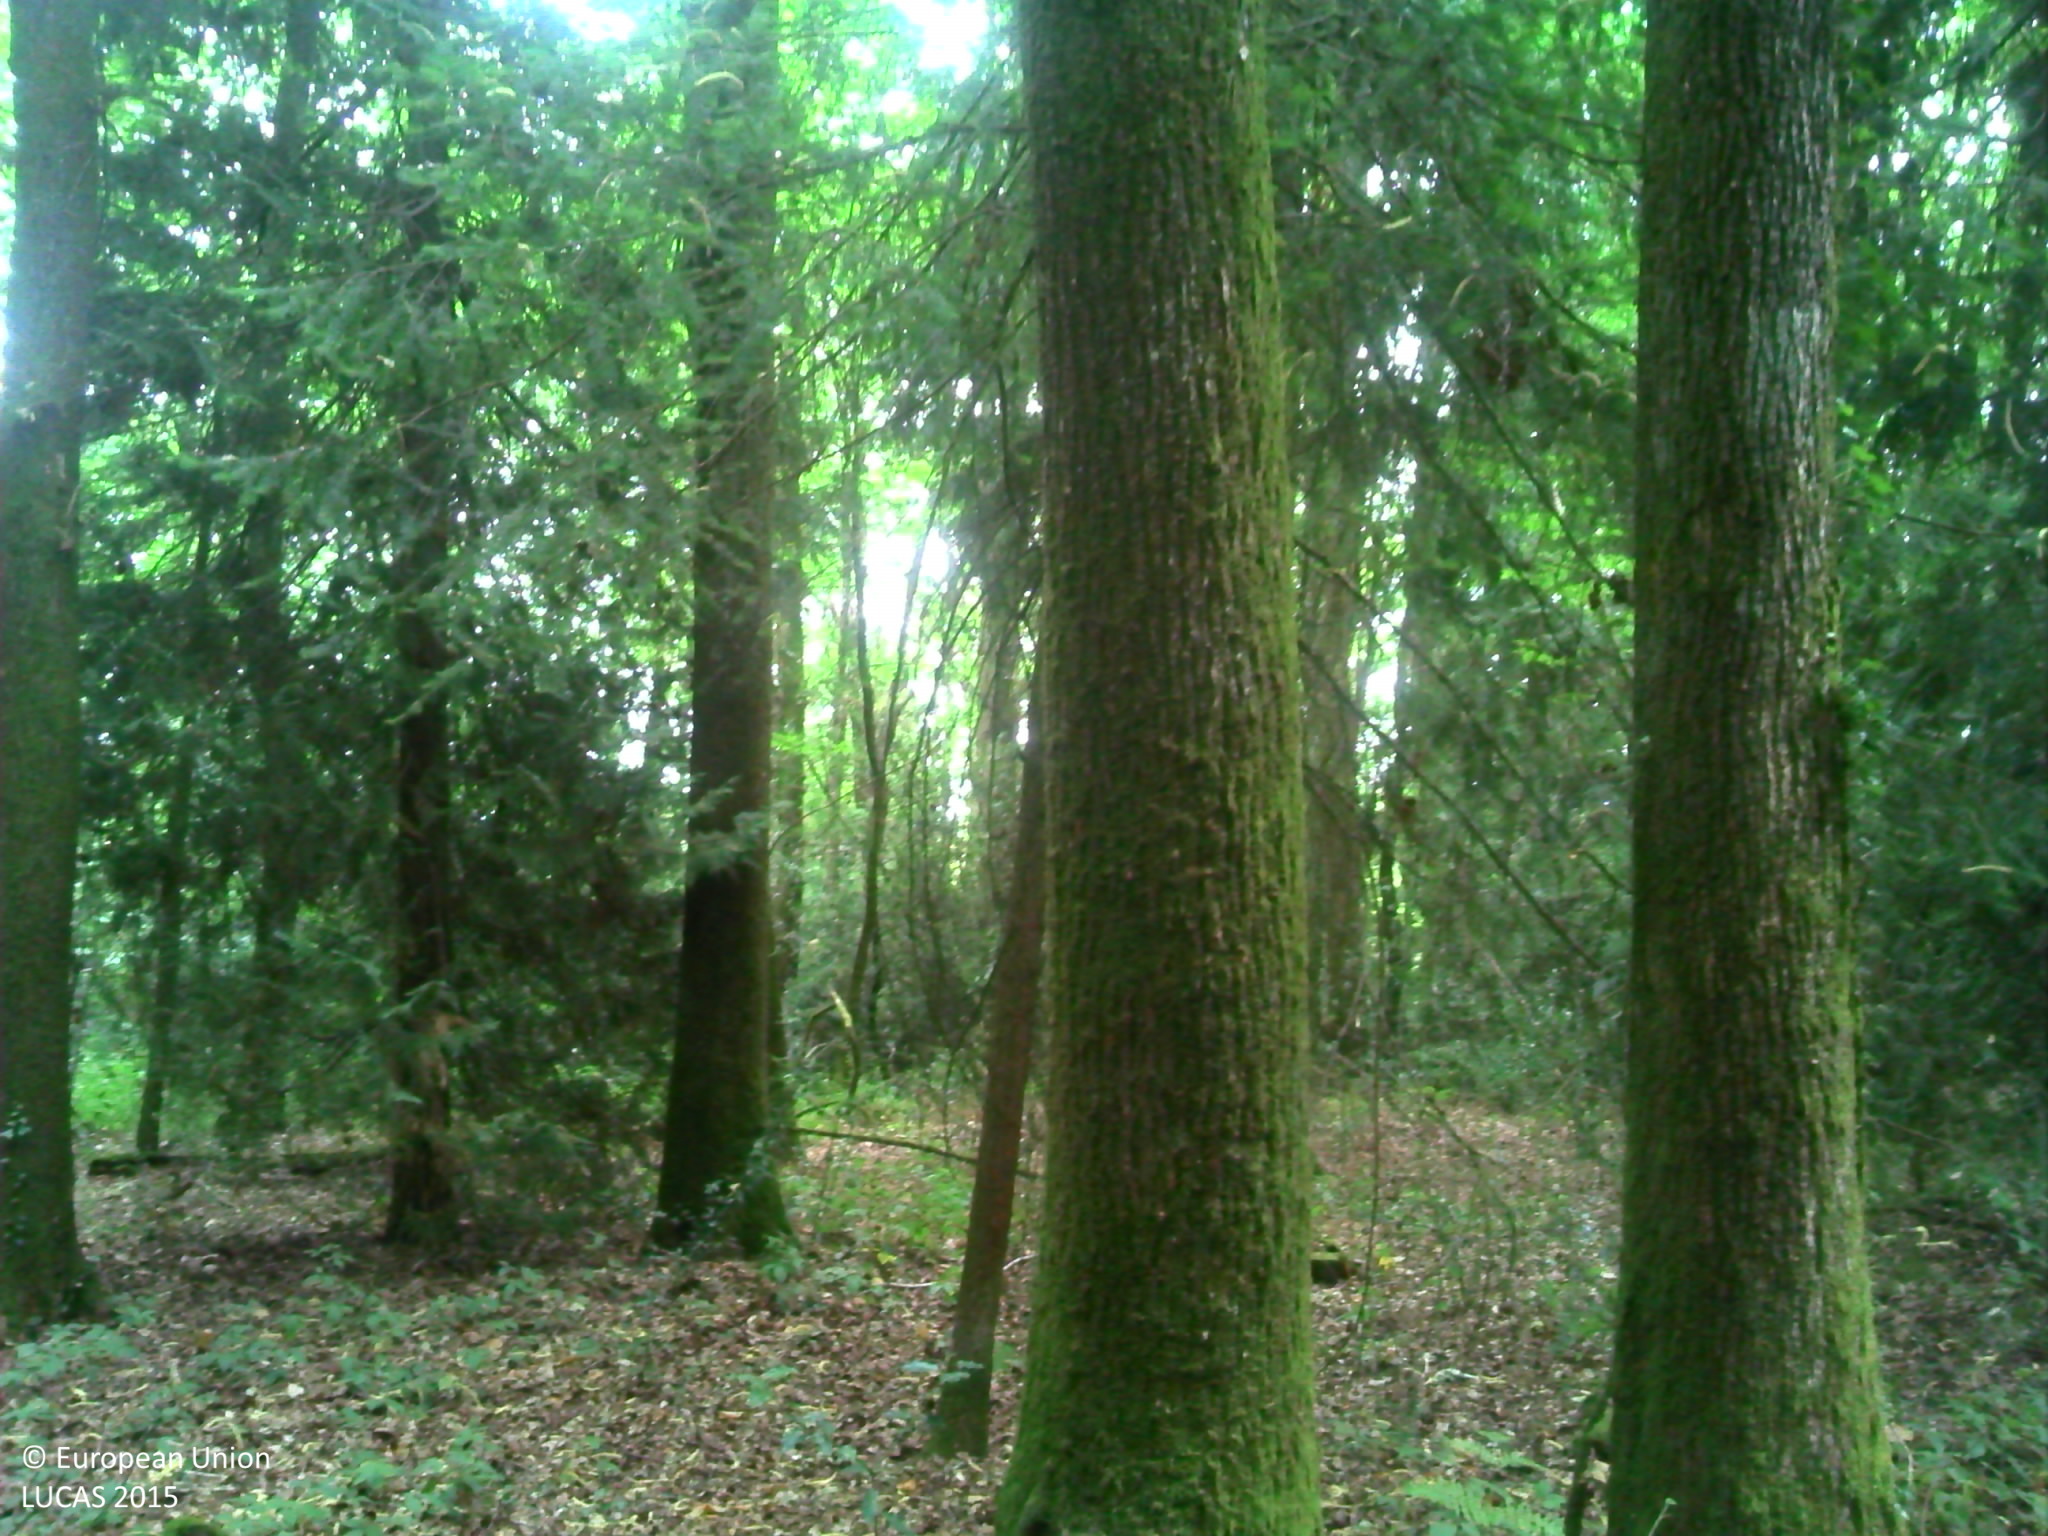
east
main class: Woodland
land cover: Spruce dominated mixed woodland
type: mesophytic deciduous forest
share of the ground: > 75 %
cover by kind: coniferous forest trees 35 %, herbaceous plants 20 %, unconsolidated bare surface 20 %, broadleaved forest trees 15 %, lichens and mosses 10 %
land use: Forestry
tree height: > 5 m
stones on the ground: 25 - 50 %
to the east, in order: Spruce dominated mixed woodland; Broadleaved woodland; Grass margins; Ditches and canals; Grass margins; Paved roads, cycling and walking lanes; Grass margins; Abandoned hedges; Fences; Grassland without tree/shrub cover; Fences; Abandoned hedges; Grass margins; Tracks; Grass margins; Rivers and streams; Broadleaved woodland; Durum wheat
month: July
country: FR
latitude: 45.5430
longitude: 1.2960
